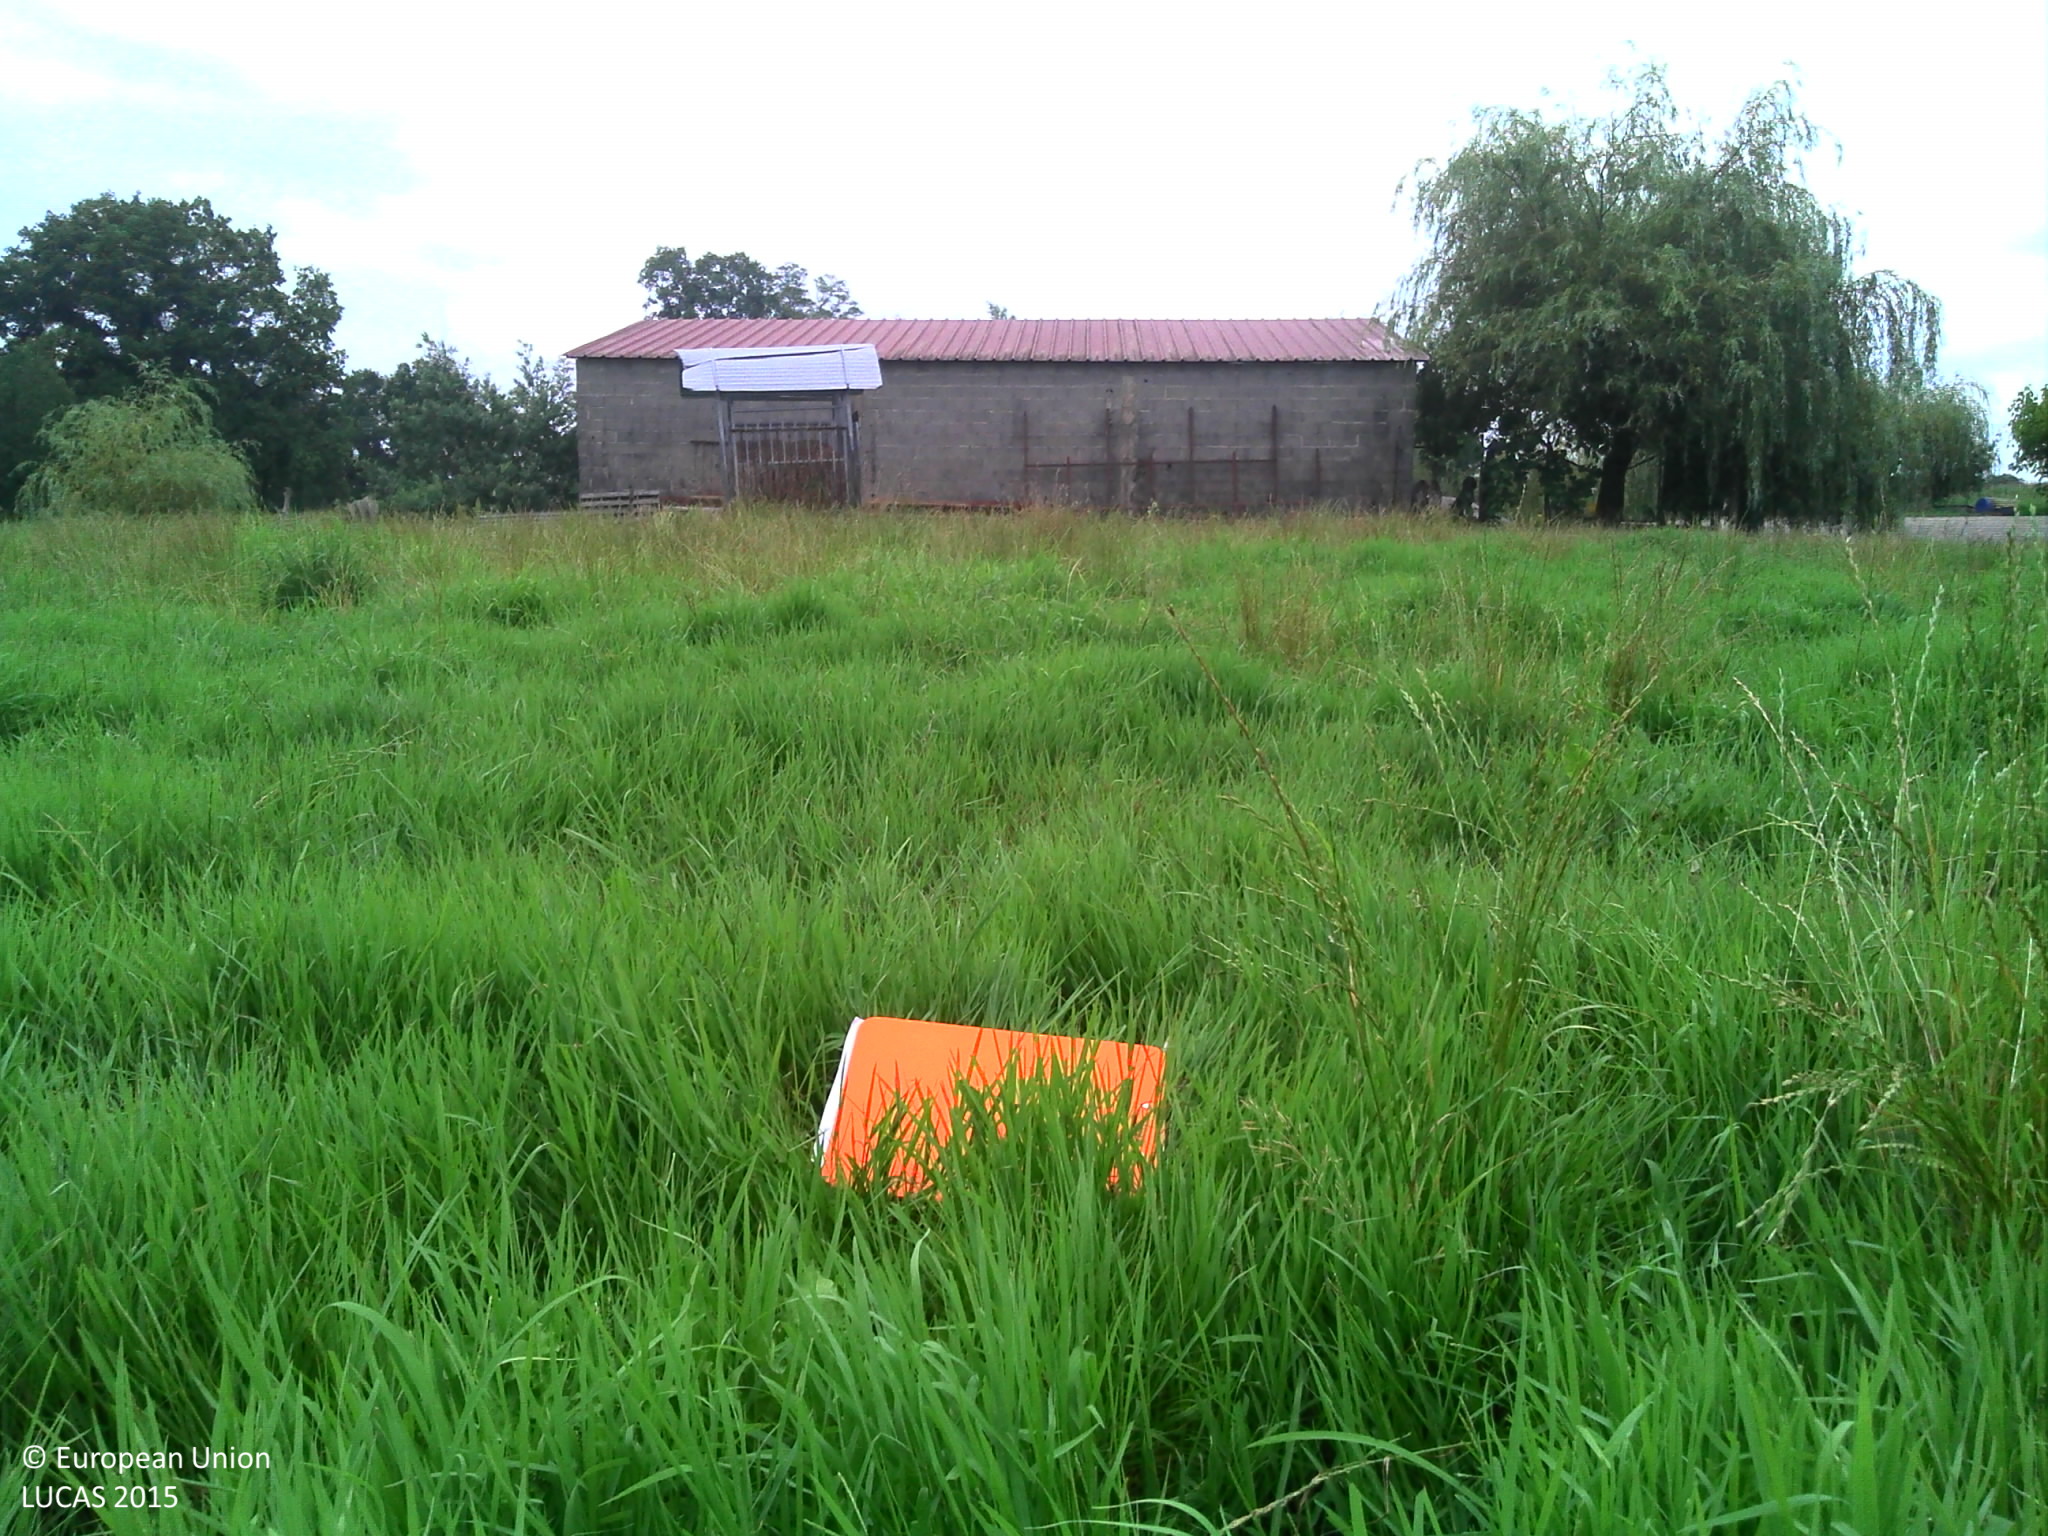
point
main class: Grassland
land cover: Grassland without tree/shrub cover
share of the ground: > 75 %
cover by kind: herbaceous plants 100 %
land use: Agriculture (excluding fallow land and kitchen gardens)
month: August
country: FR
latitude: 43.4976
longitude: -1.1078
